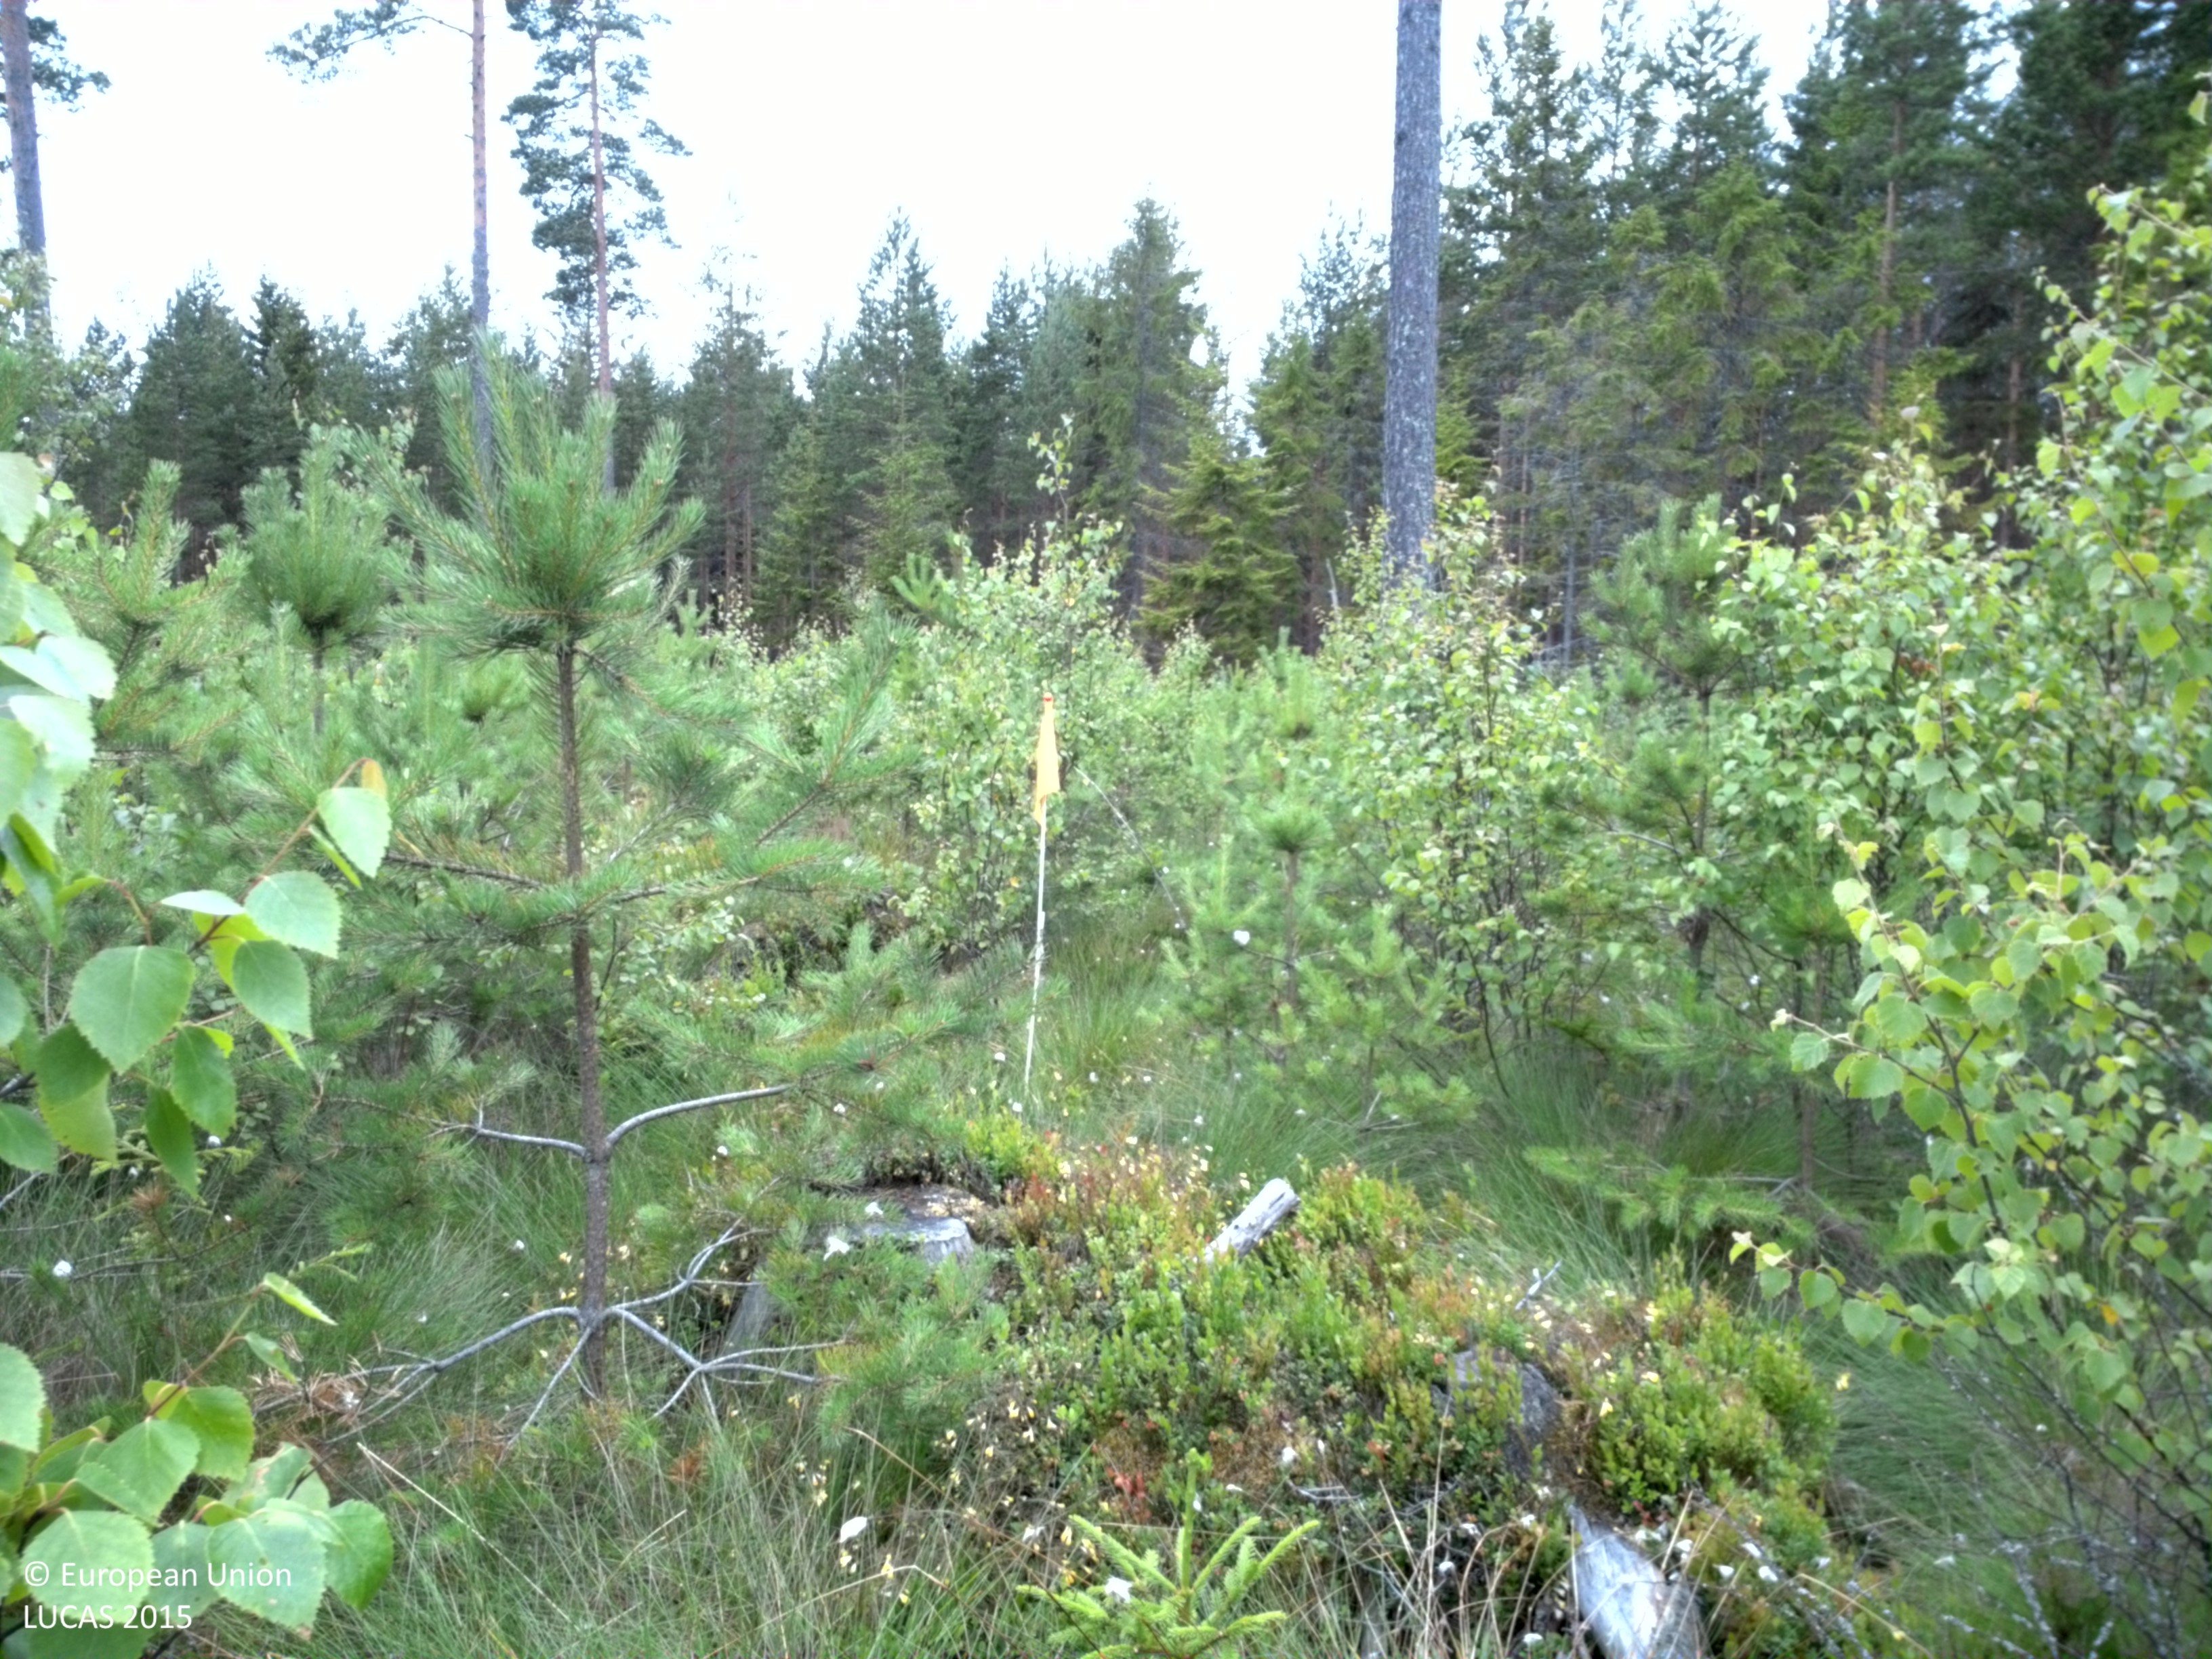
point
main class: Woodland
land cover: Pine dominated mixed woodland
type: boreal forest
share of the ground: 50 - 75 %
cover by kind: coniferous forest trees 45 %, broadleaved forest trees 25 %, herbaceous plants 25 %, shrubs 5 %
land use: Forestry
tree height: > 5 m
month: July
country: SE
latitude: 58.9542
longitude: 14.5297
